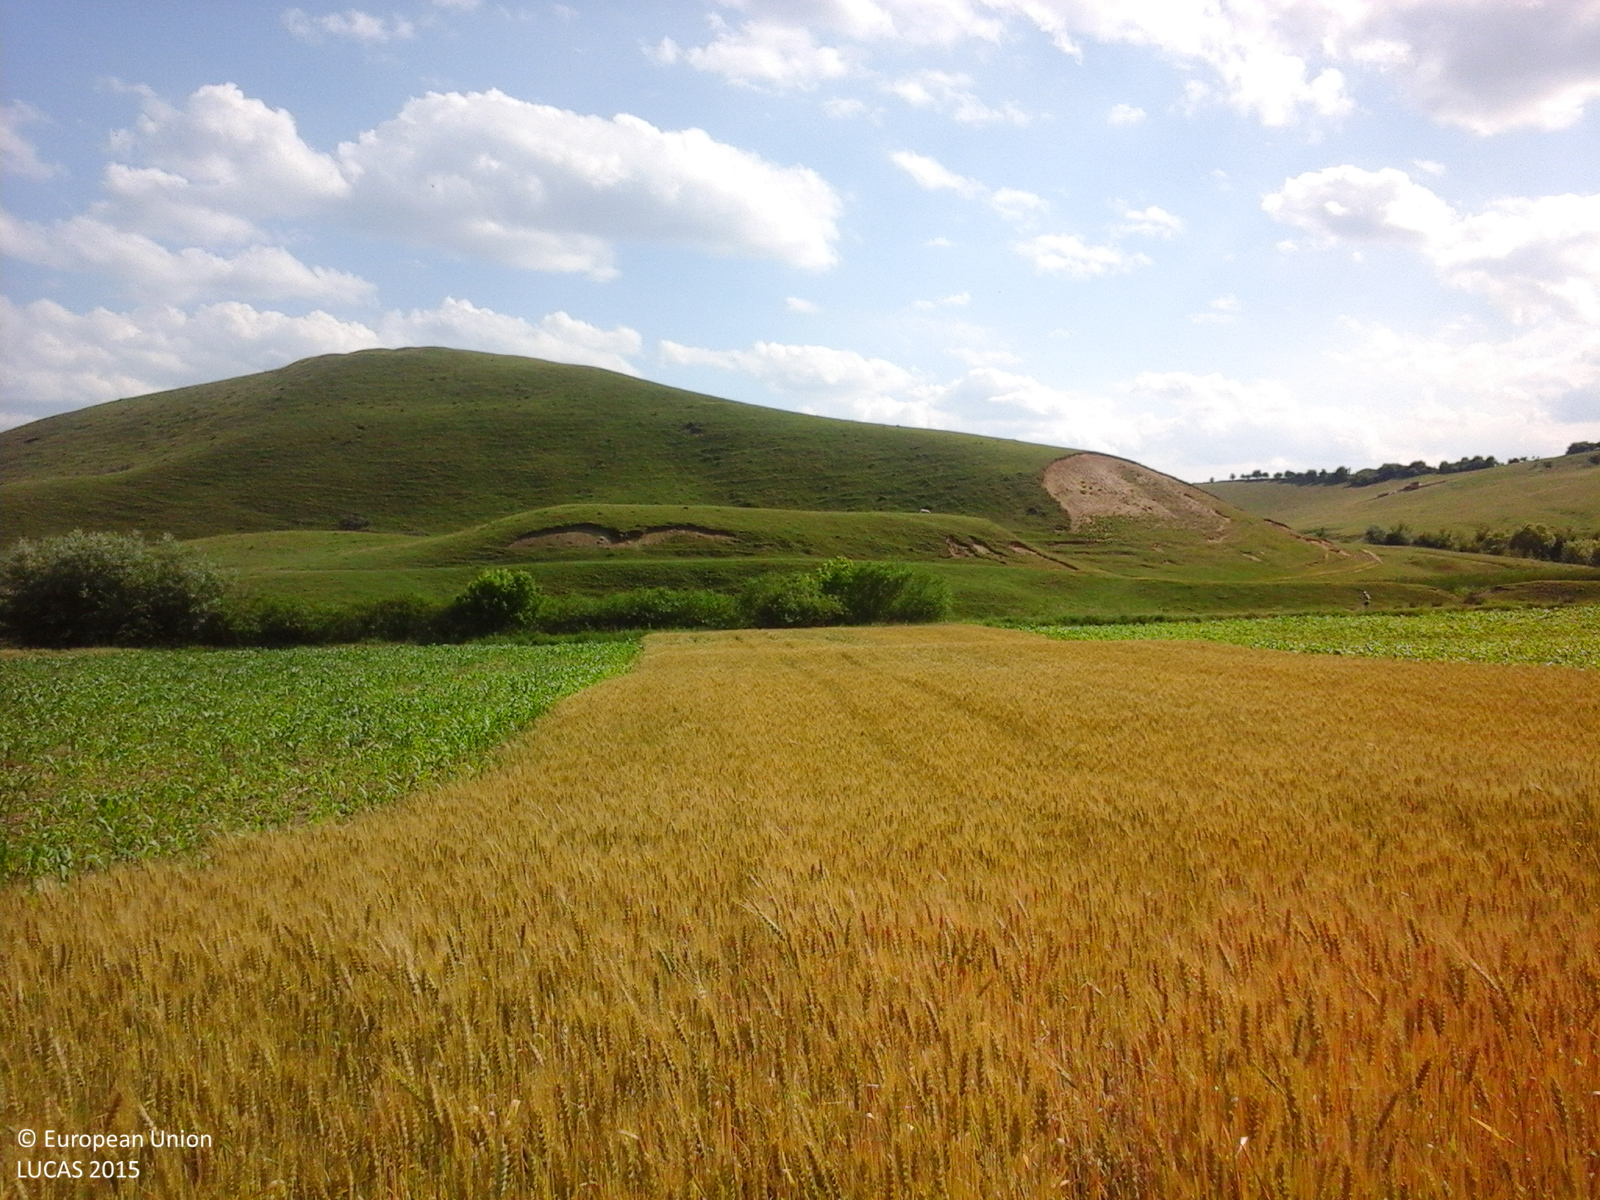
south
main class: Cropland
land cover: Common wheat
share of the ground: > 75 %
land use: Agriculture (excluding fallow land and kitchen gardens)
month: June
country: RO
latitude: 47.9282
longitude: 26.3491
